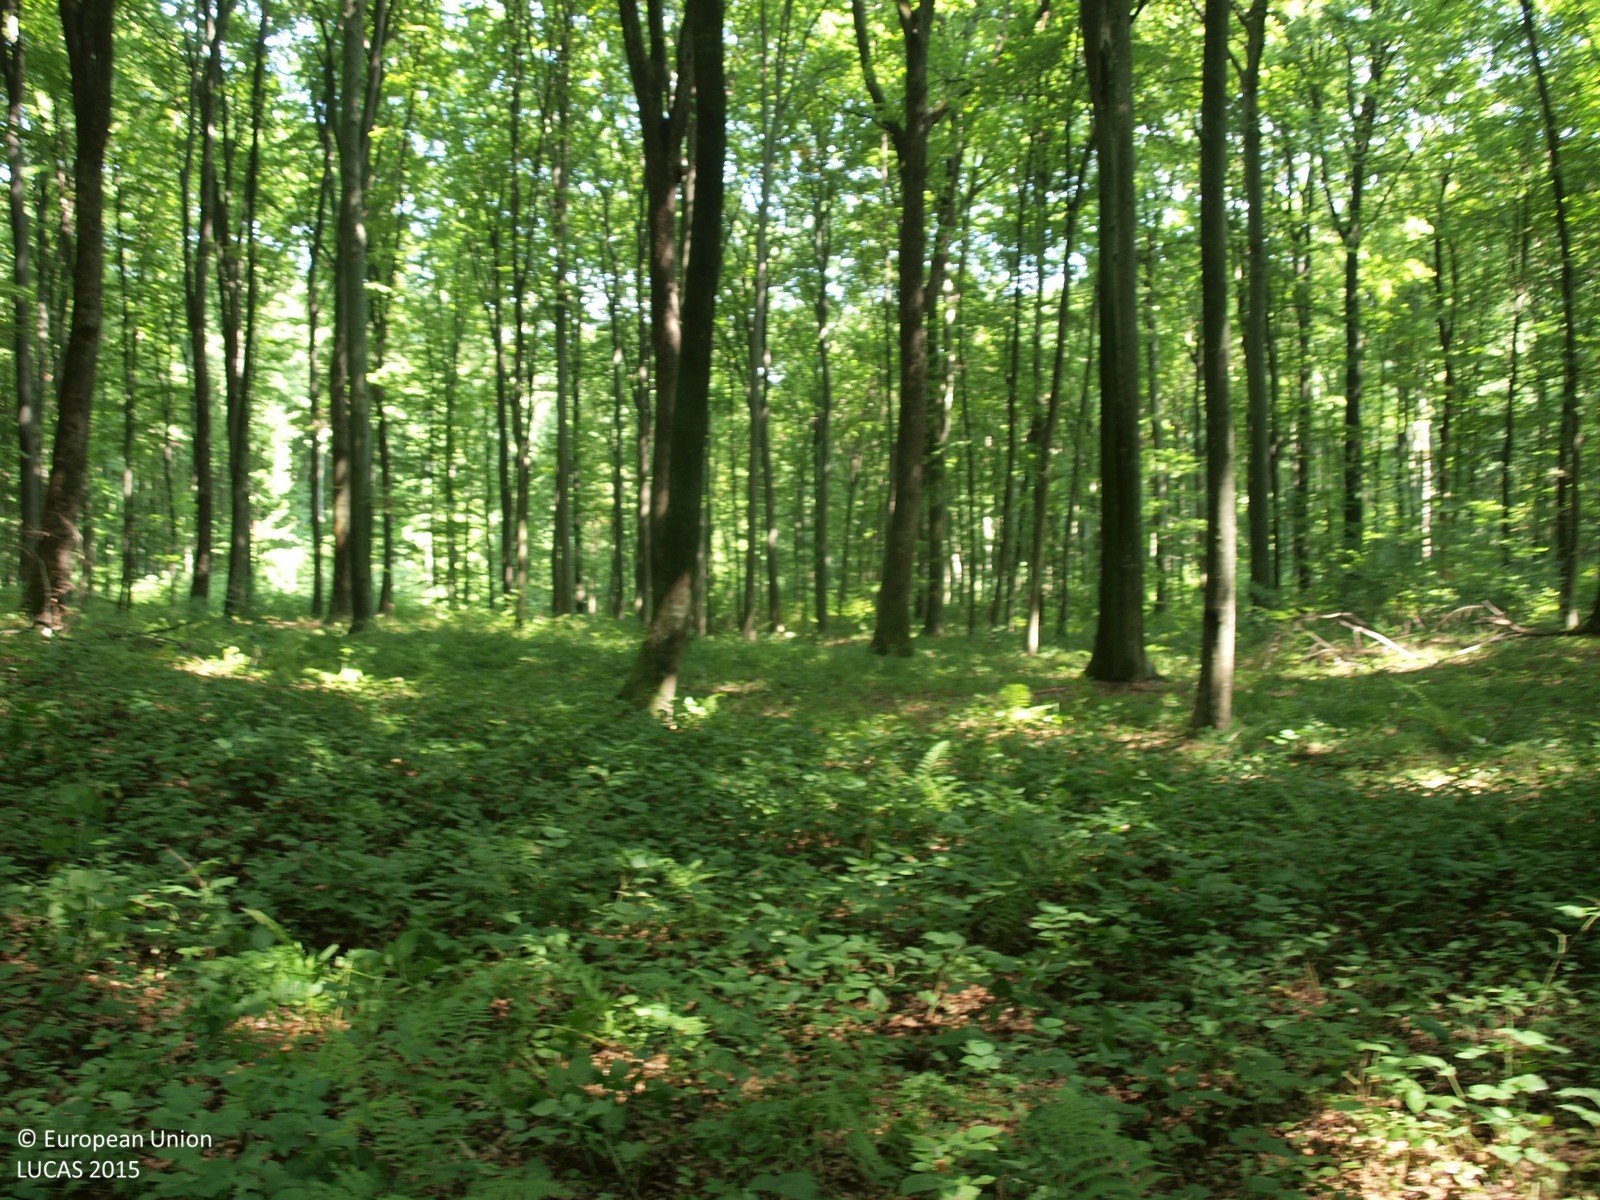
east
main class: Woodland
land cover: Broadleaved woodland
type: beech forest
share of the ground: > 75 %
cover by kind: broadleaved forest trees 100 %
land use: Forestry
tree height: > 5 m
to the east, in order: Broadleaved woodland
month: August
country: HR
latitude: 45.9654
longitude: 16.6199
